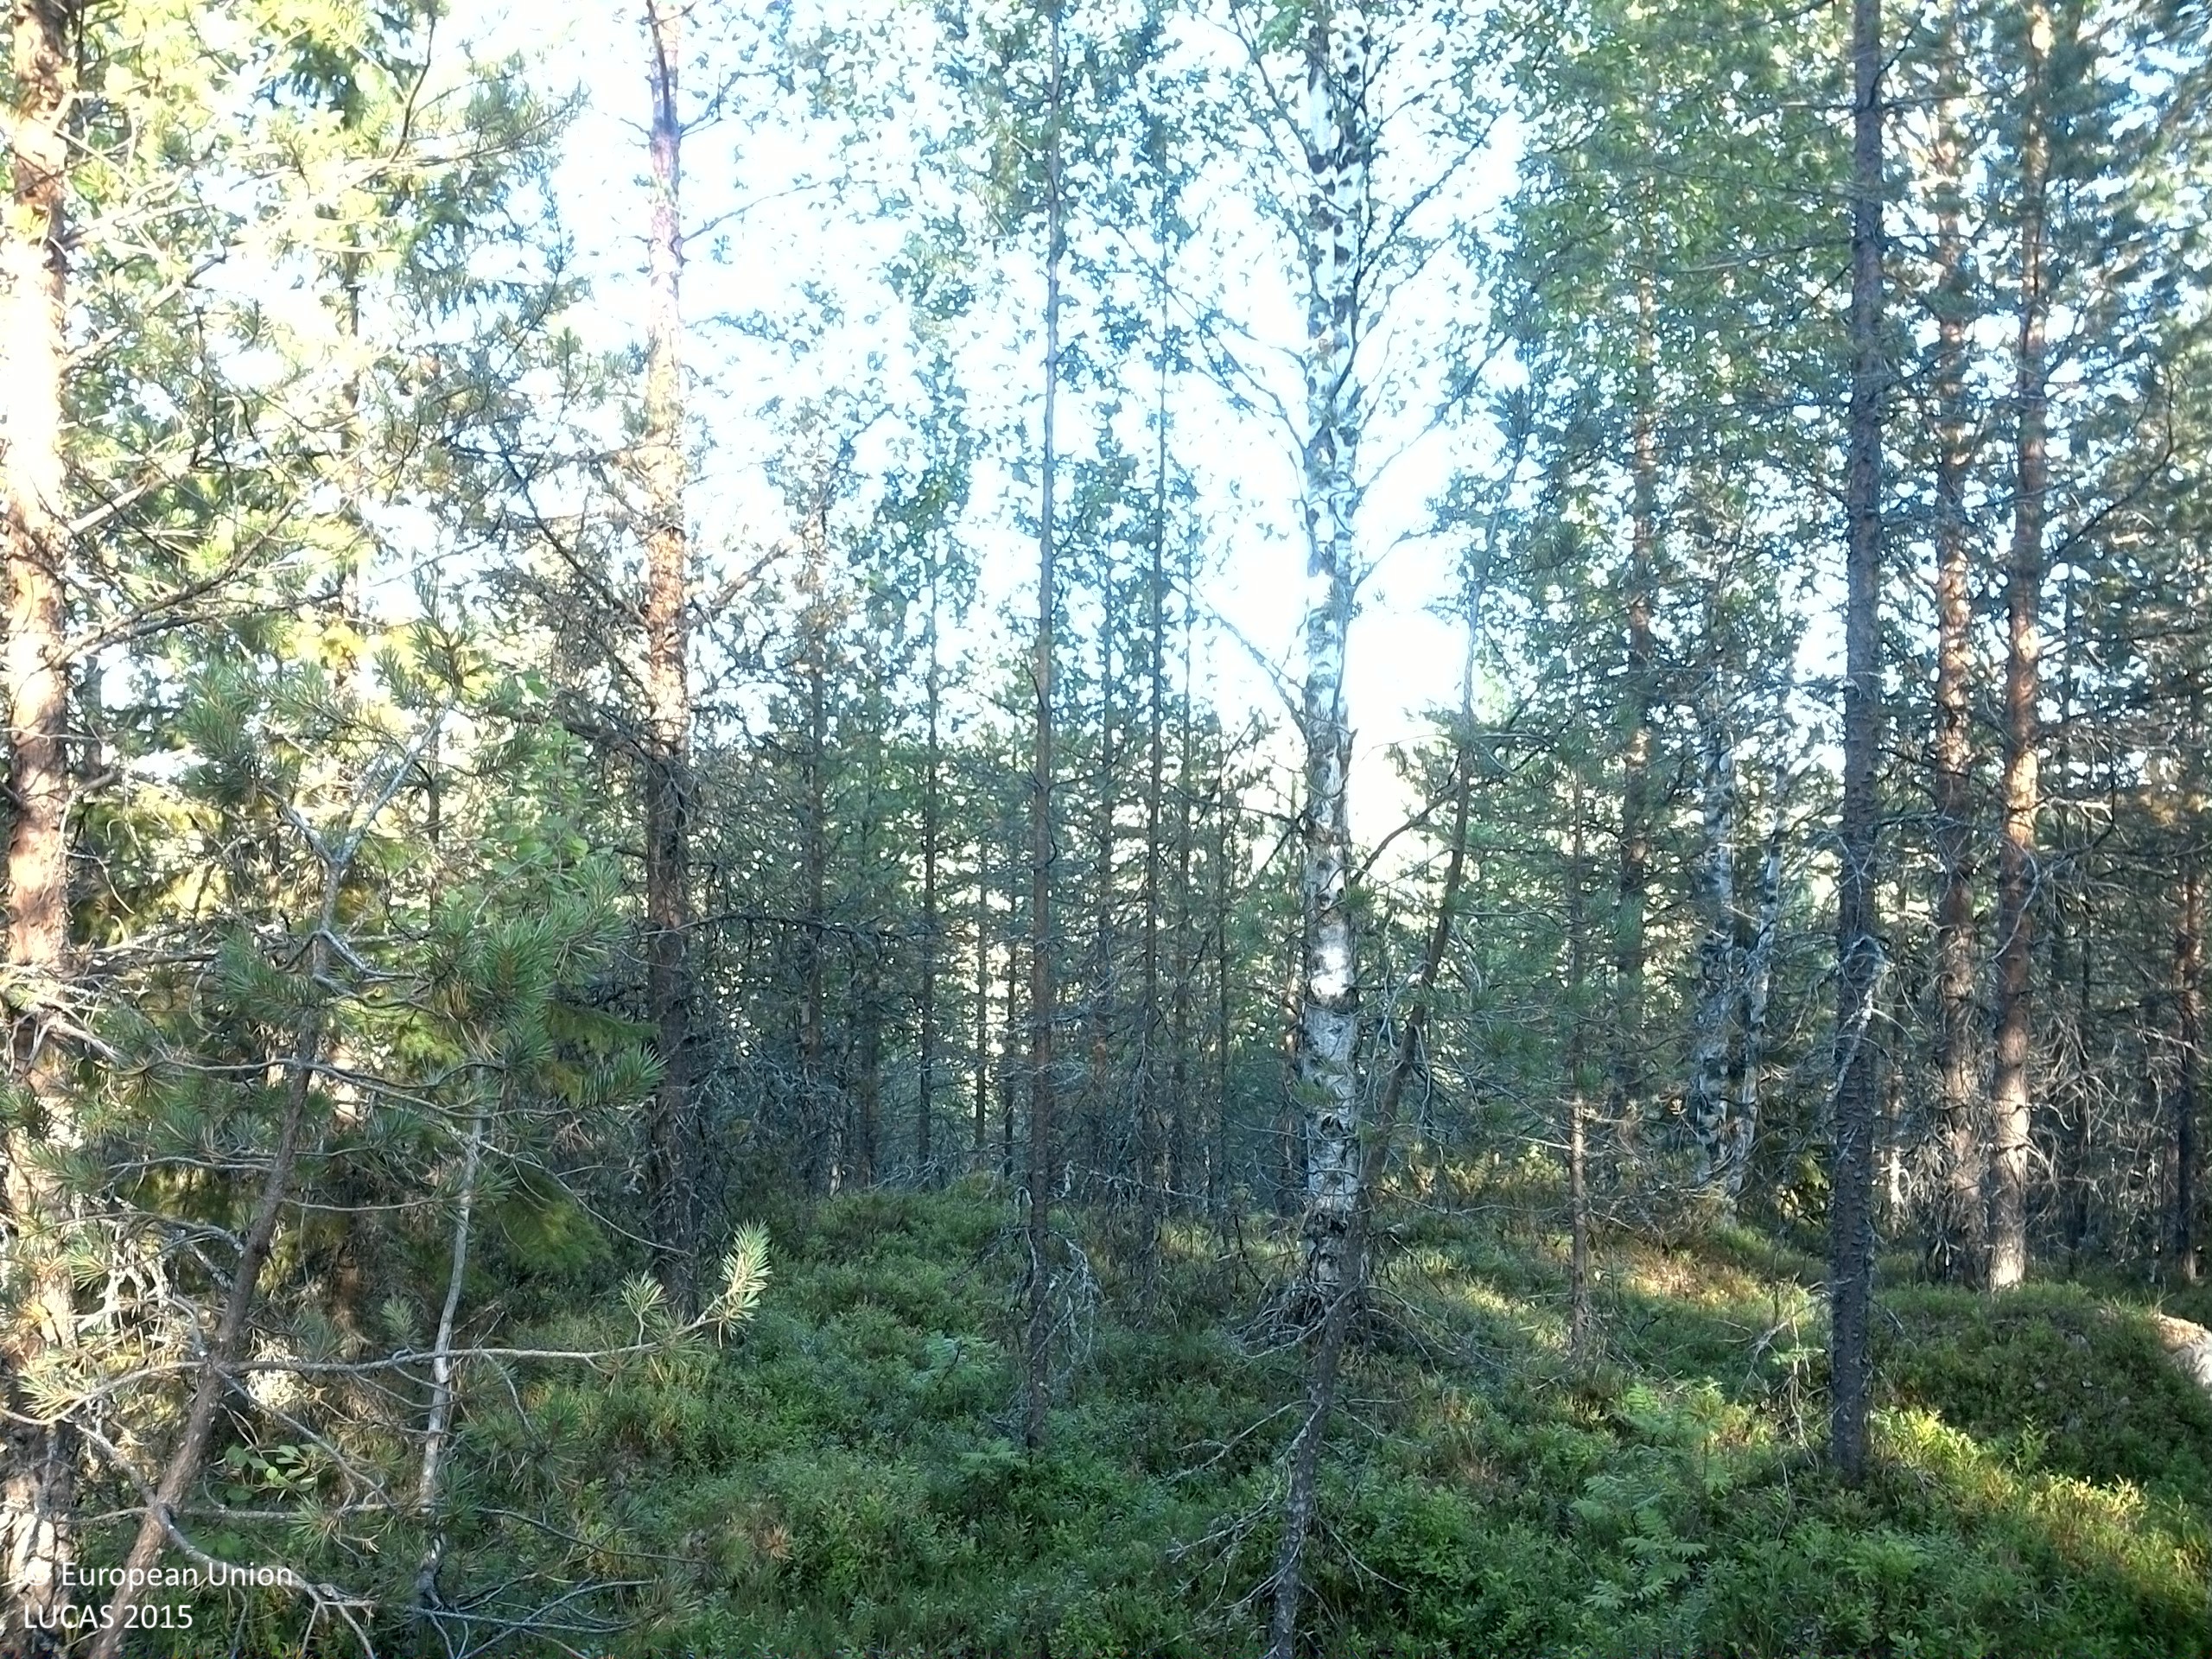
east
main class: Woodland
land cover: Pine dominated coniferous woodland
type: boreal forest
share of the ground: 50 - 75 %
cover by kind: coniferous forest trees 60 %, shrubs 30 %, broadleaved forest trees 10 %
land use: Forestry
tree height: < 5 m
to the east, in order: Pine dominated coniferous woodland; Pine dominated mixed woodland; Spruce dominated mixed woodland; Pine dominated mixed woodland; Spruce dominated mixed woodland
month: August
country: SE
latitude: 63.7794
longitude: 17.6201
